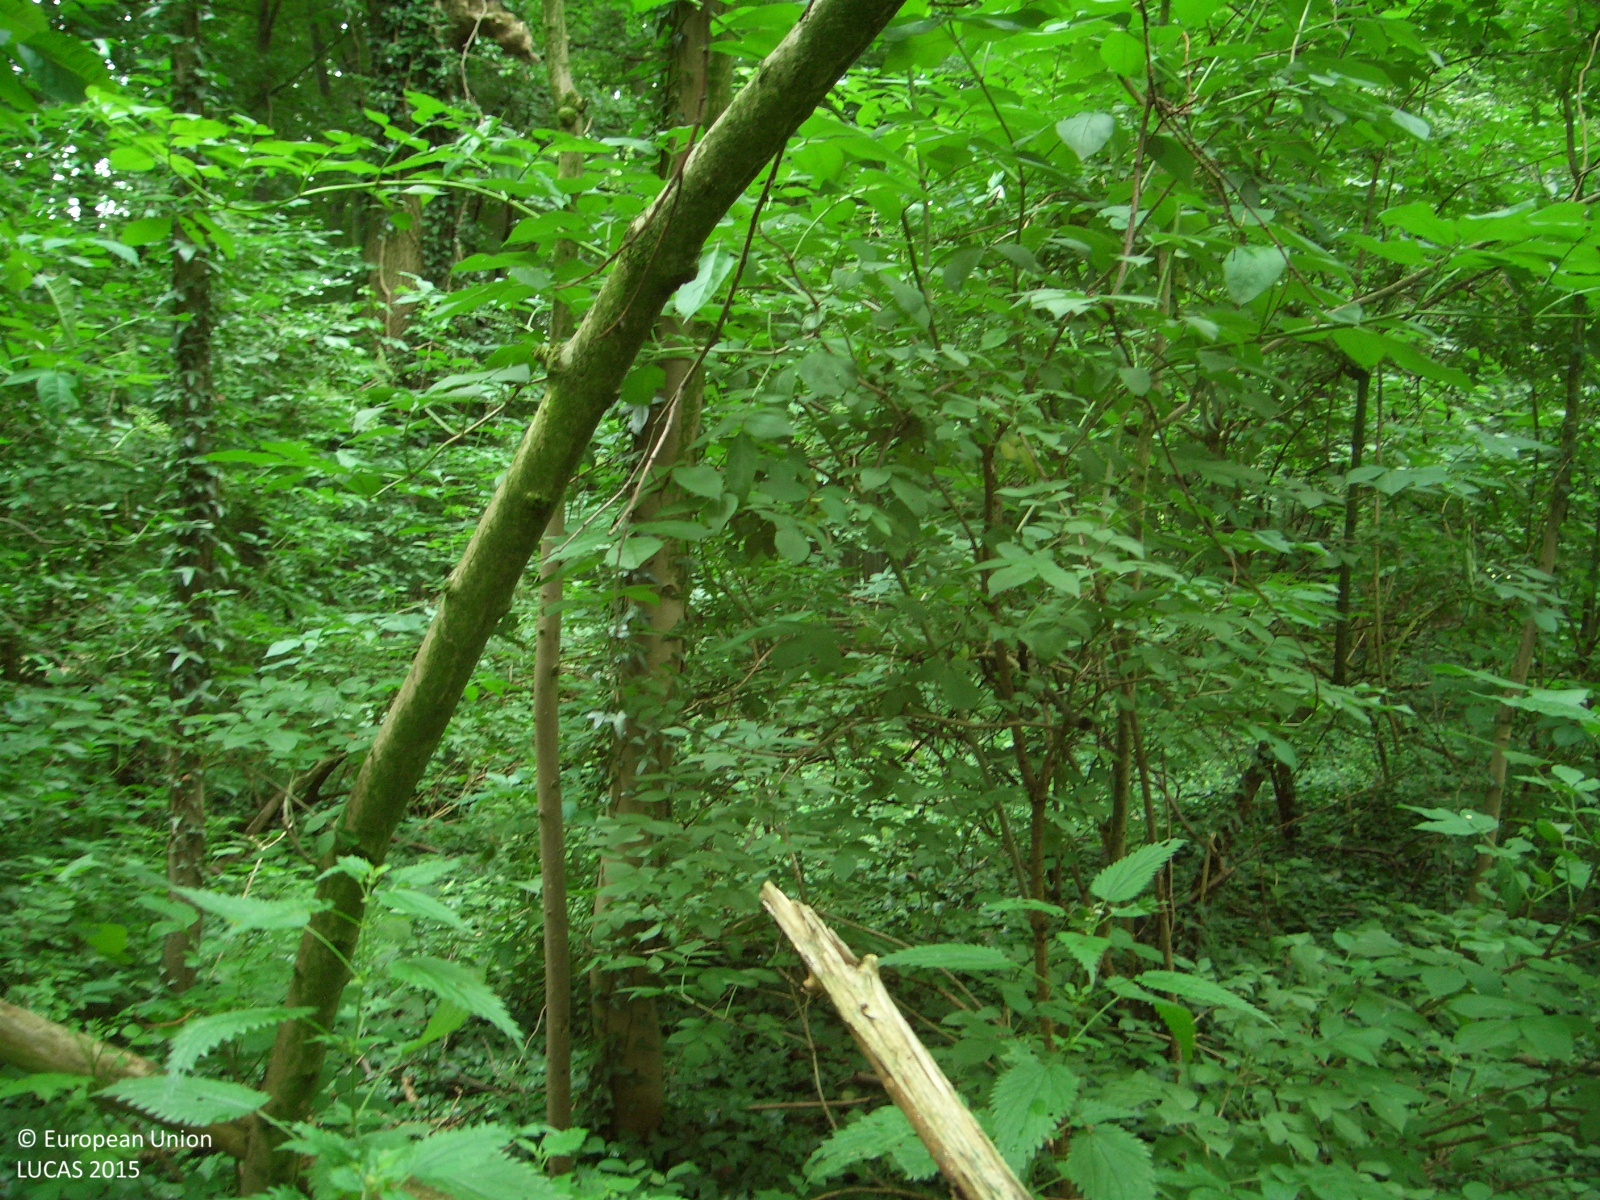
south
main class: Woodland
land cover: Broadleaved woodland
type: mesophytic deciduous forest
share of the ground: > 75 %
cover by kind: broadleaved forest trees 90 %, herbaceous plants 10 %
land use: Forestry
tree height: > 5 m
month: July
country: DE
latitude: 51.5650
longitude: 6.9561
